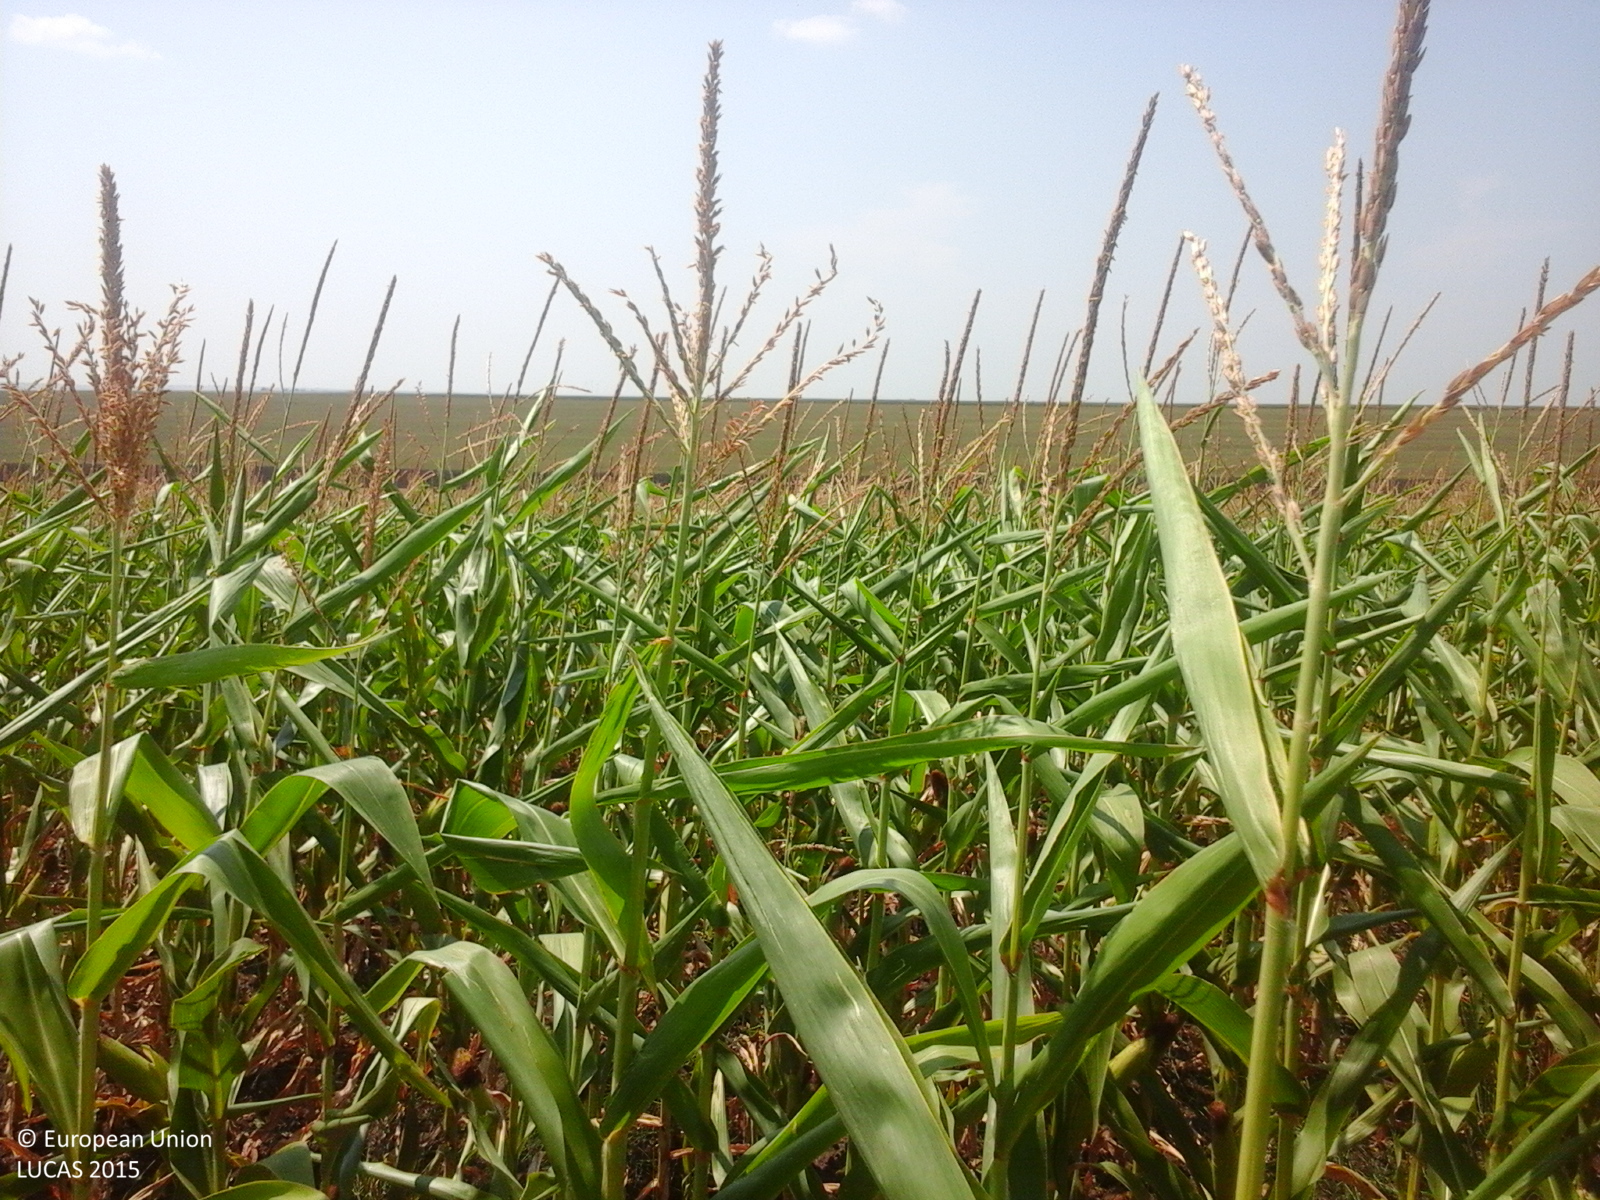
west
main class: Cropland
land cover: Maize
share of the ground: > 75 %
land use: Agriculture (excluding fallow land and kitchen gardens)
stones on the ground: < 10 %
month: July
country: RO
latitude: 45.8961
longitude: 27.9973
